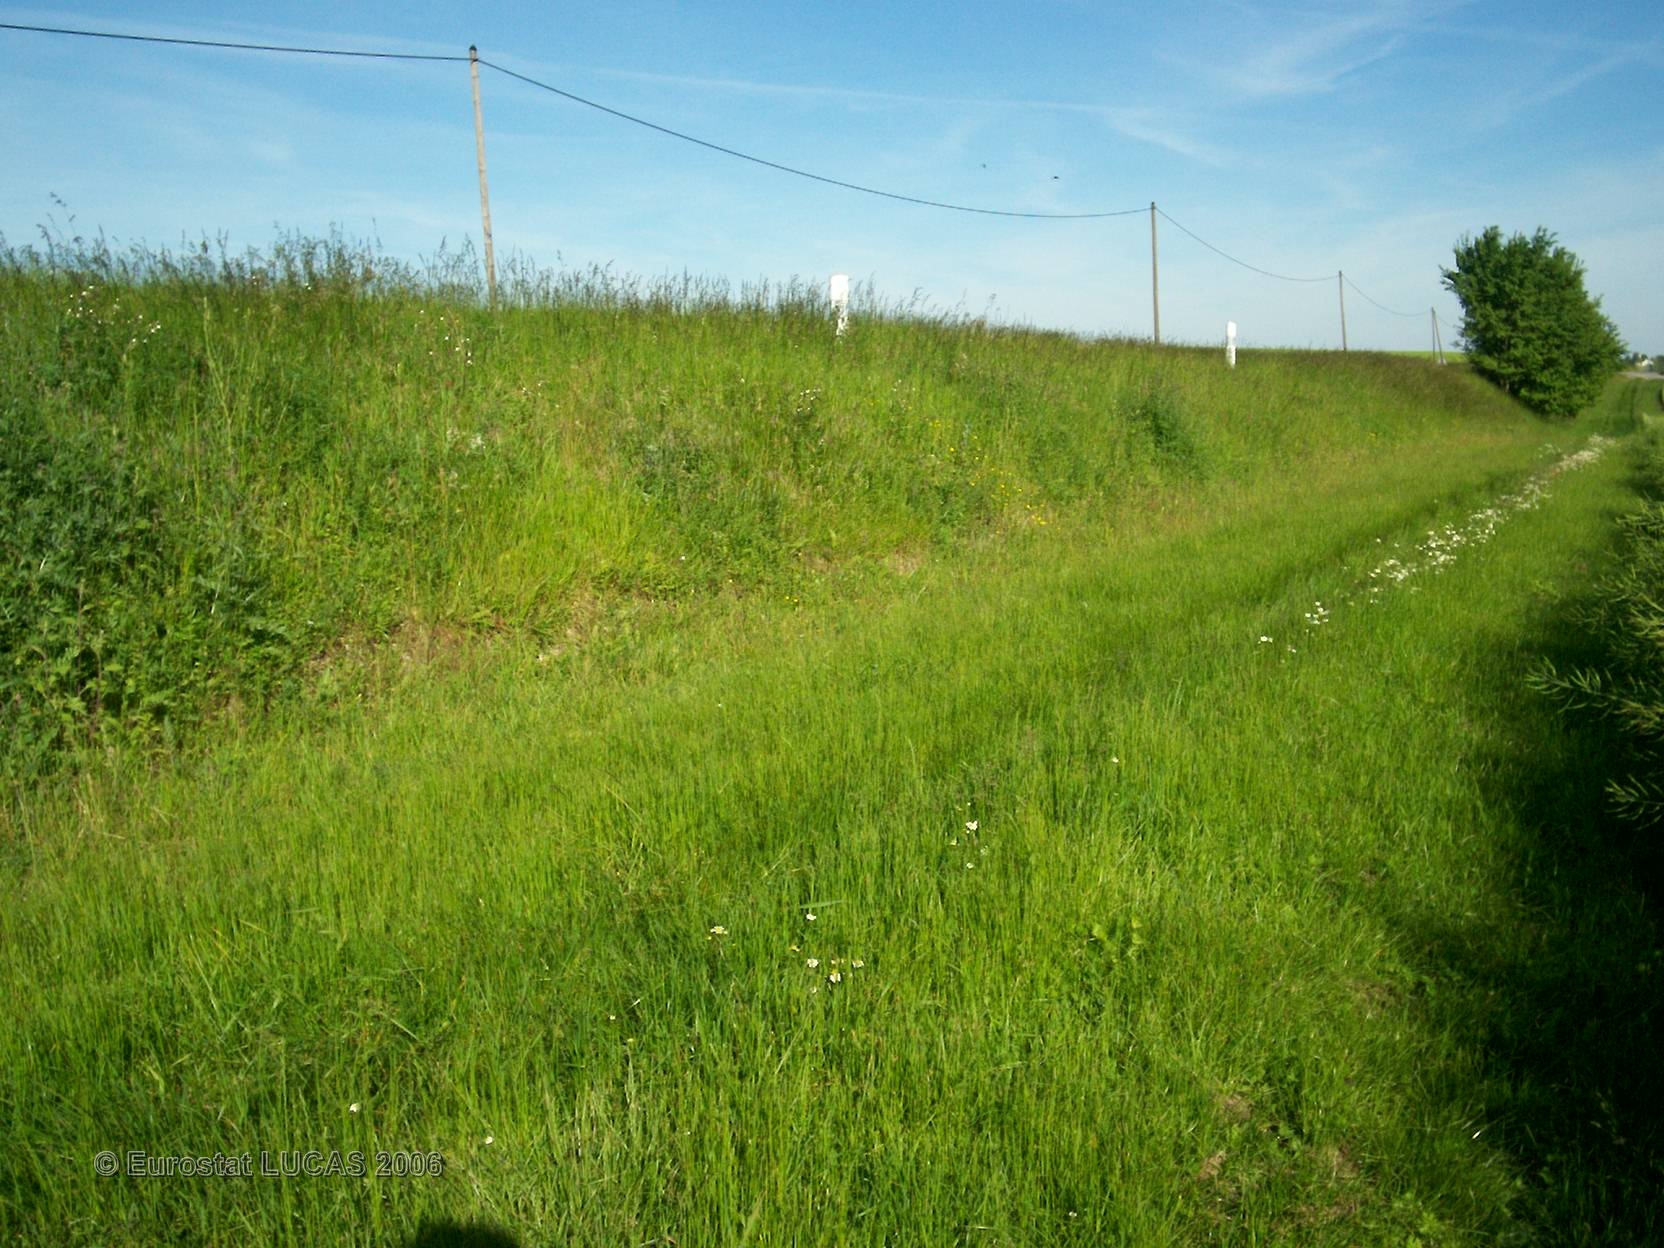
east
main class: Cropland
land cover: Rape and turnip rape
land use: Agriculture (excluding fallow land and kitchen gardens)
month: June
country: FR
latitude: 48.9748
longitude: 4.6005
